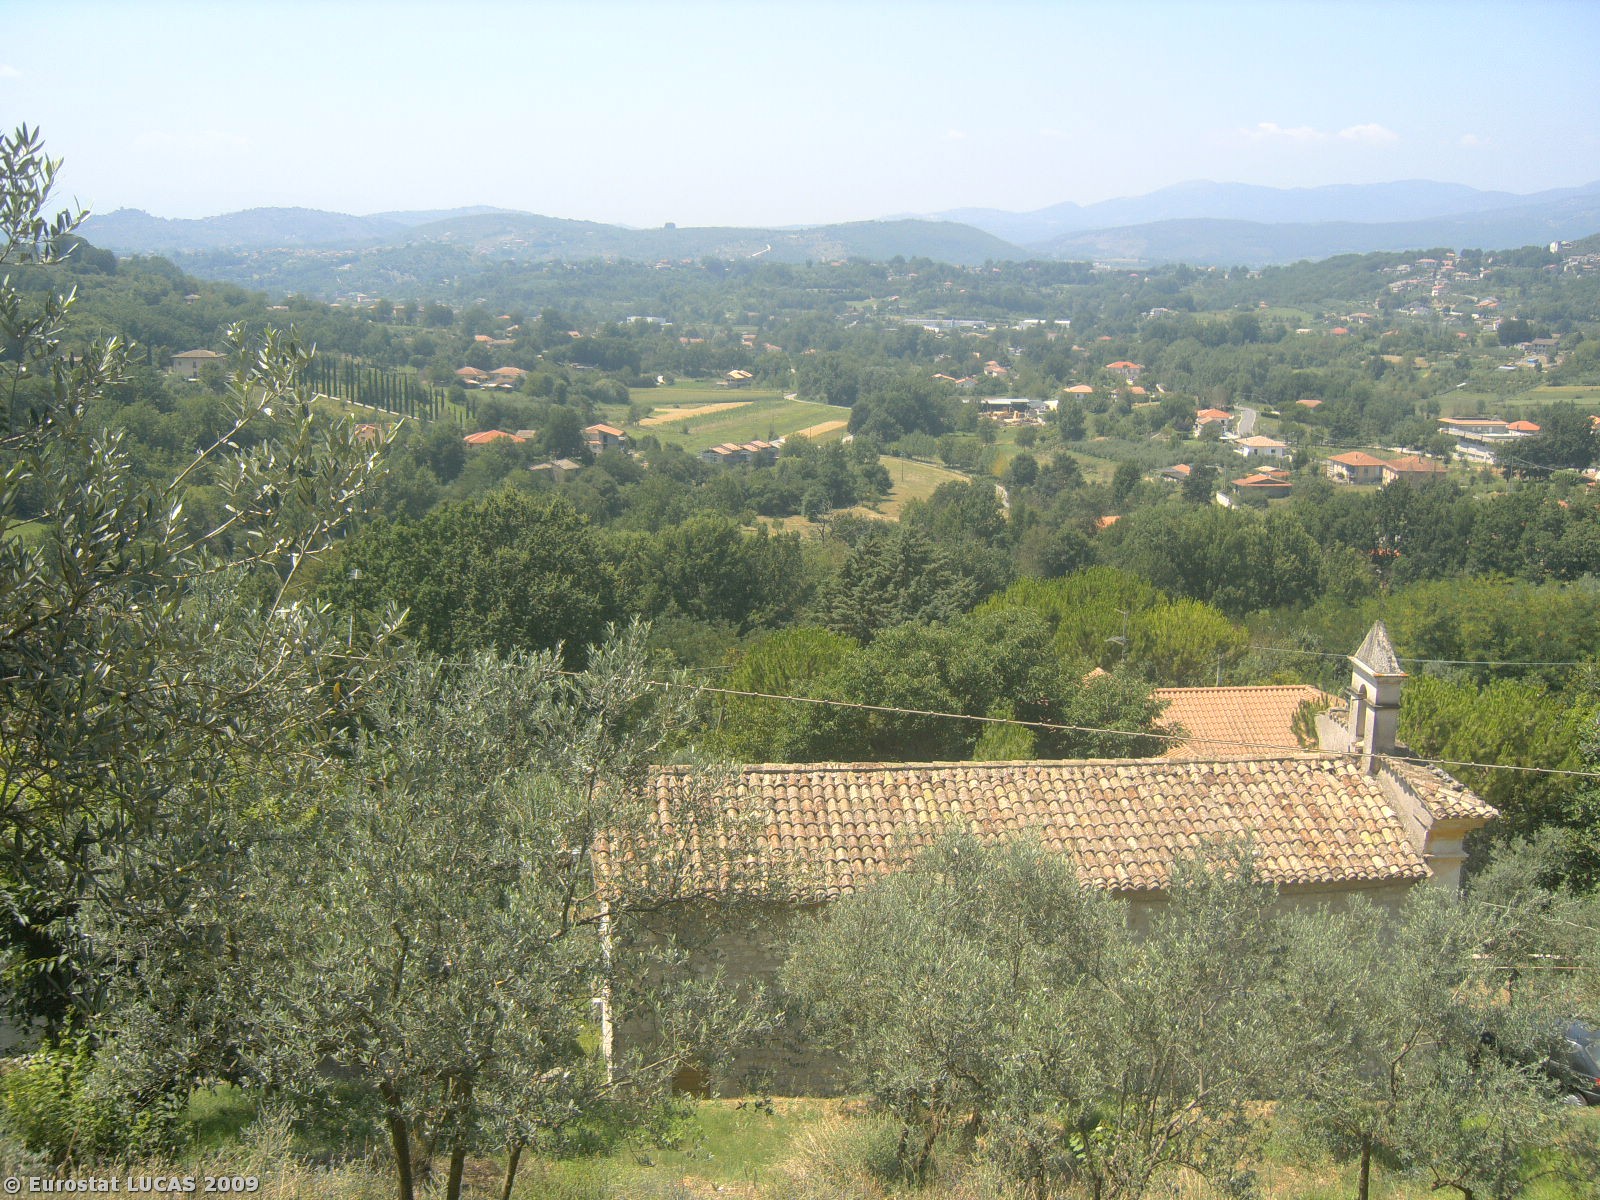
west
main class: Cropland
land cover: Olive groves
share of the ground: > 75 %
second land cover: Grassland with sparse tree/shrub cover
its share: 25 - 50 %
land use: Agriculture (excluding fallow land and kitchen gardens)
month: July
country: IT
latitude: 41.6496
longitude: 13.6008
